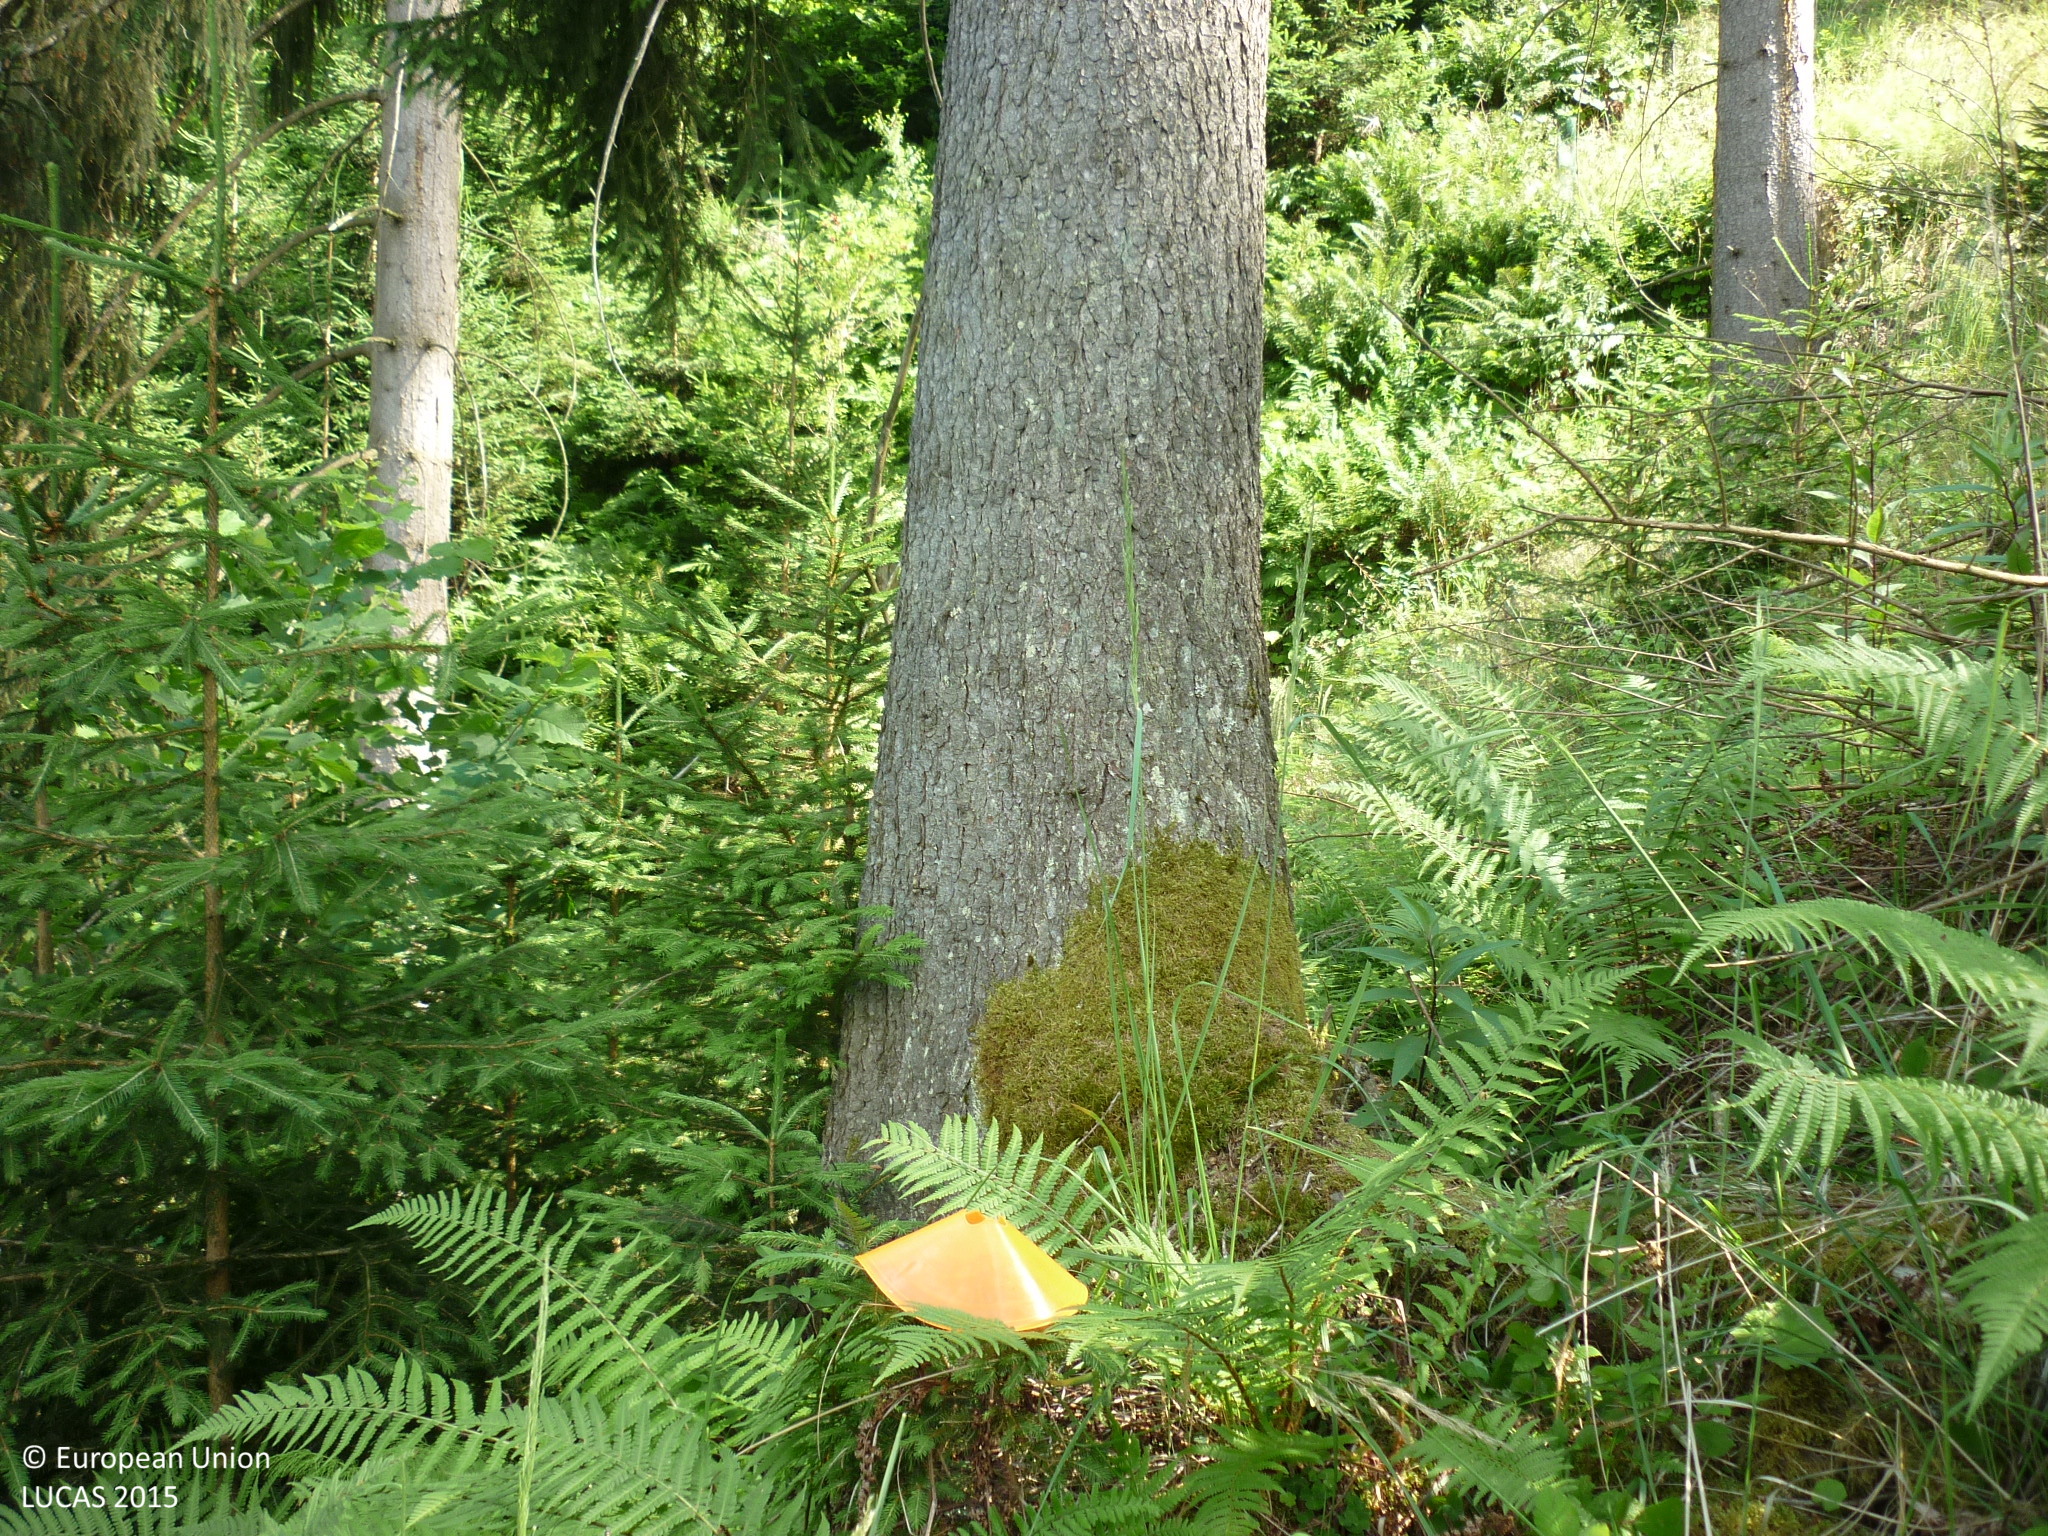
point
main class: Woodland
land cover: Spruce dominated coniferous woodland
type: alpine coniferous forest
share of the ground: 50 - 75 %
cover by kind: coniferous forest trees 40 %, herbaceous plants 30 %, shrubs 20 %, broadleaved forest trees 10 %
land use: Forestry
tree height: > 5 m
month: July
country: AT
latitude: 47.1964
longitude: 14.8697
